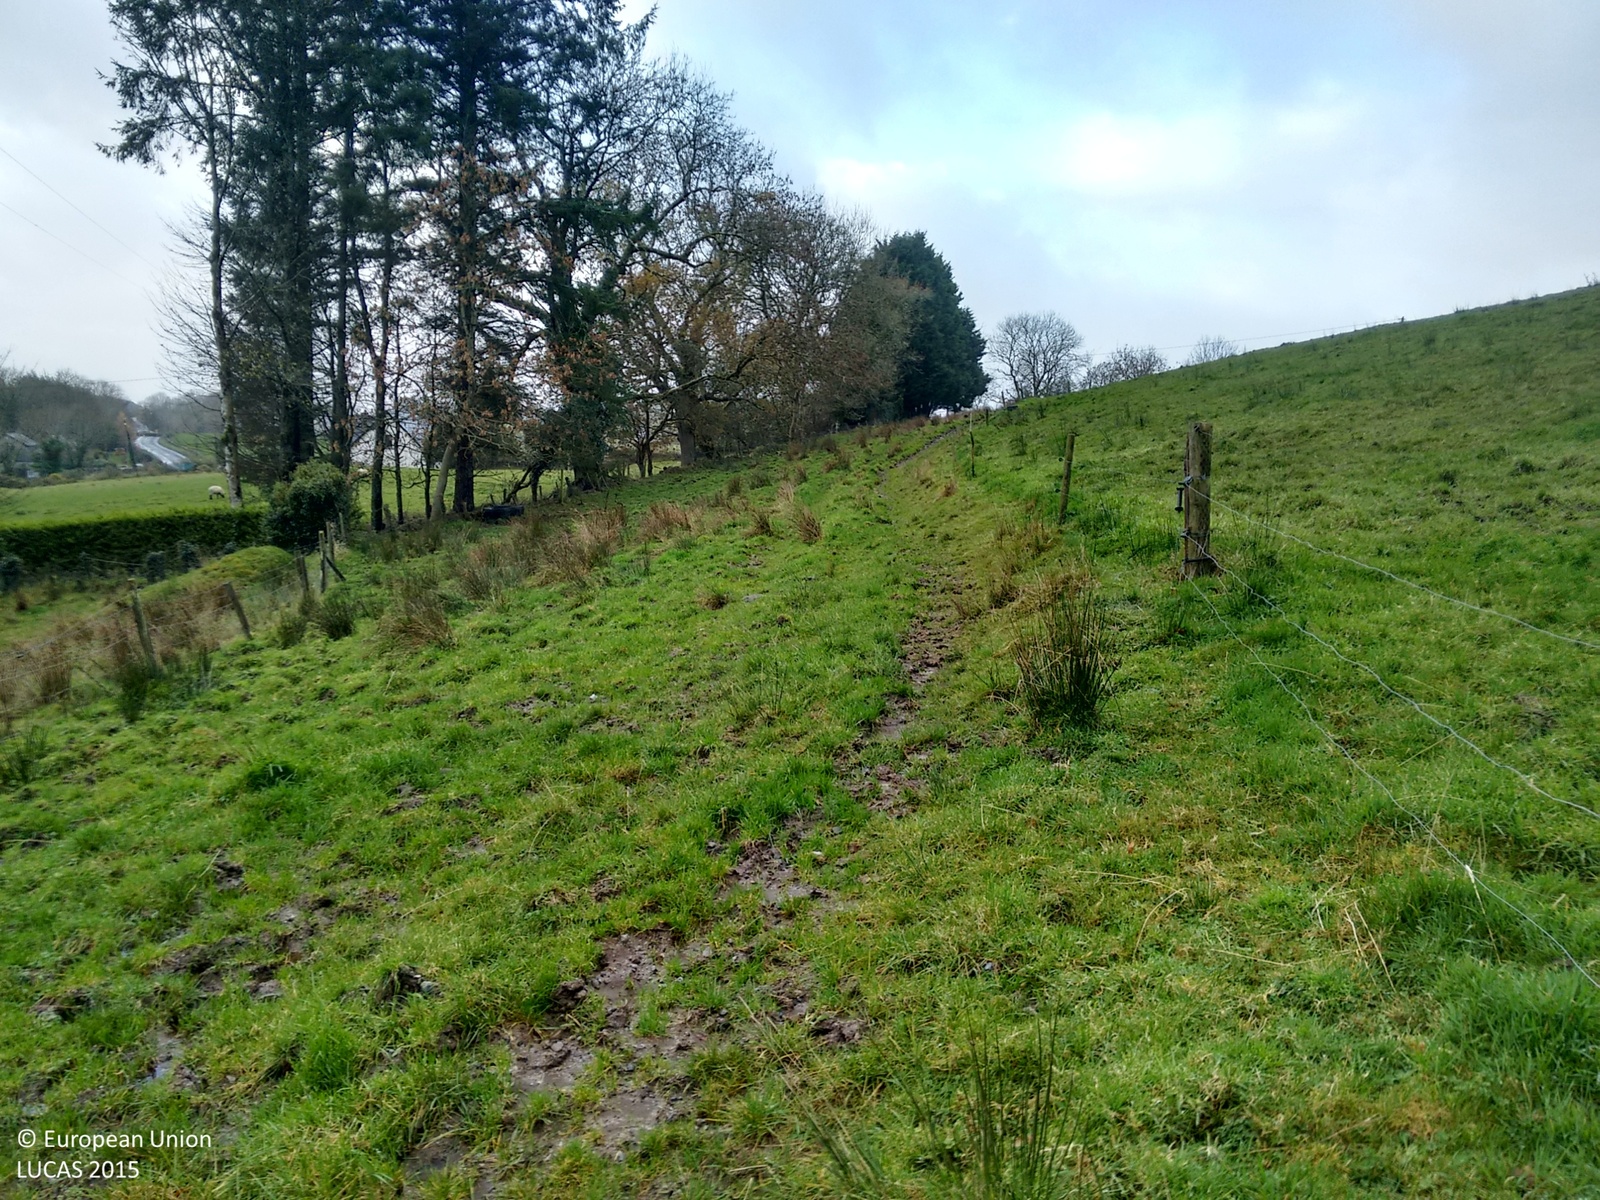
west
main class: Grassland
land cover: Grassland without tree/shrub cover
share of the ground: > 75 %
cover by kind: herbaceous plants 100 %
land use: Agriculture (excluding fallow land and kitchen gardens)
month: November
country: IE
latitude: 54.2852
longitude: -8.3903
